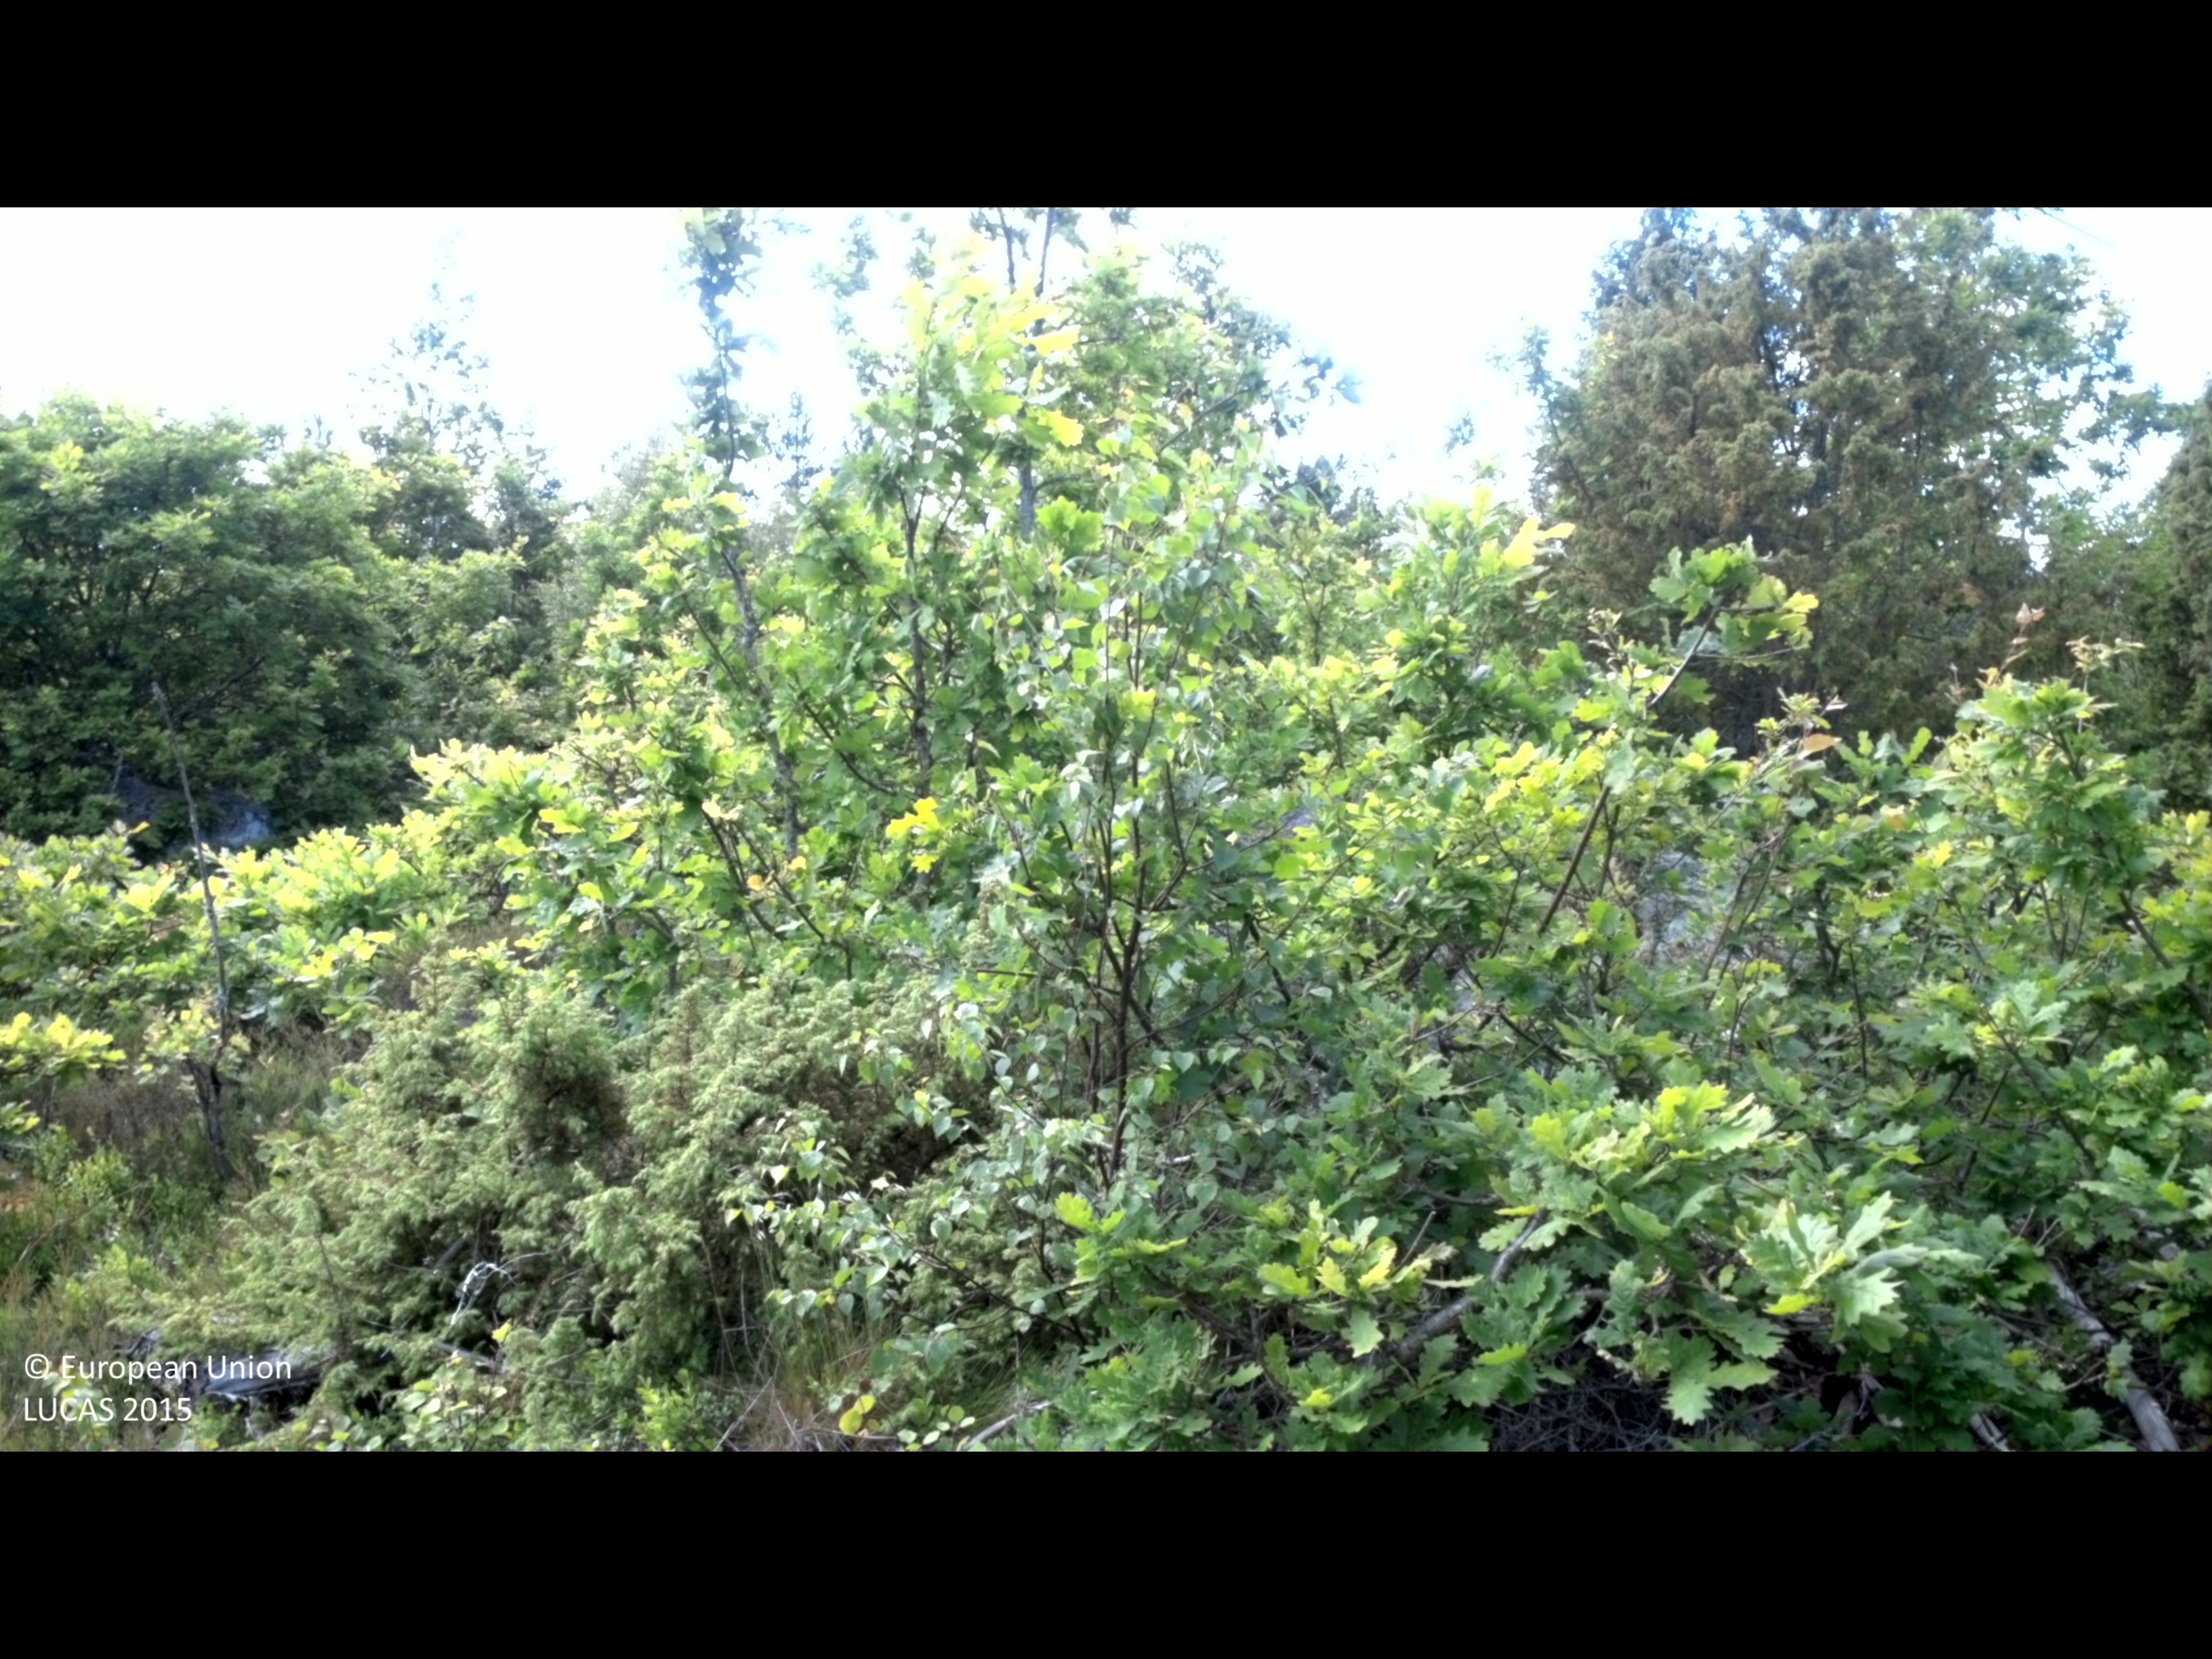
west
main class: Woodland
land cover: Other mixed woodland
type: boreal forest
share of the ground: 50 - 75 %
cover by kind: broadleaved forest trees 35 %, coniferous forest trees 30 %, shrubs 20 %, lichens and mosses 10 %, consolidated bare surface 5 %
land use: Forestry
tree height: > 5 m
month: June
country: SE
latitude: 57.7112
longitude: 16.6624
